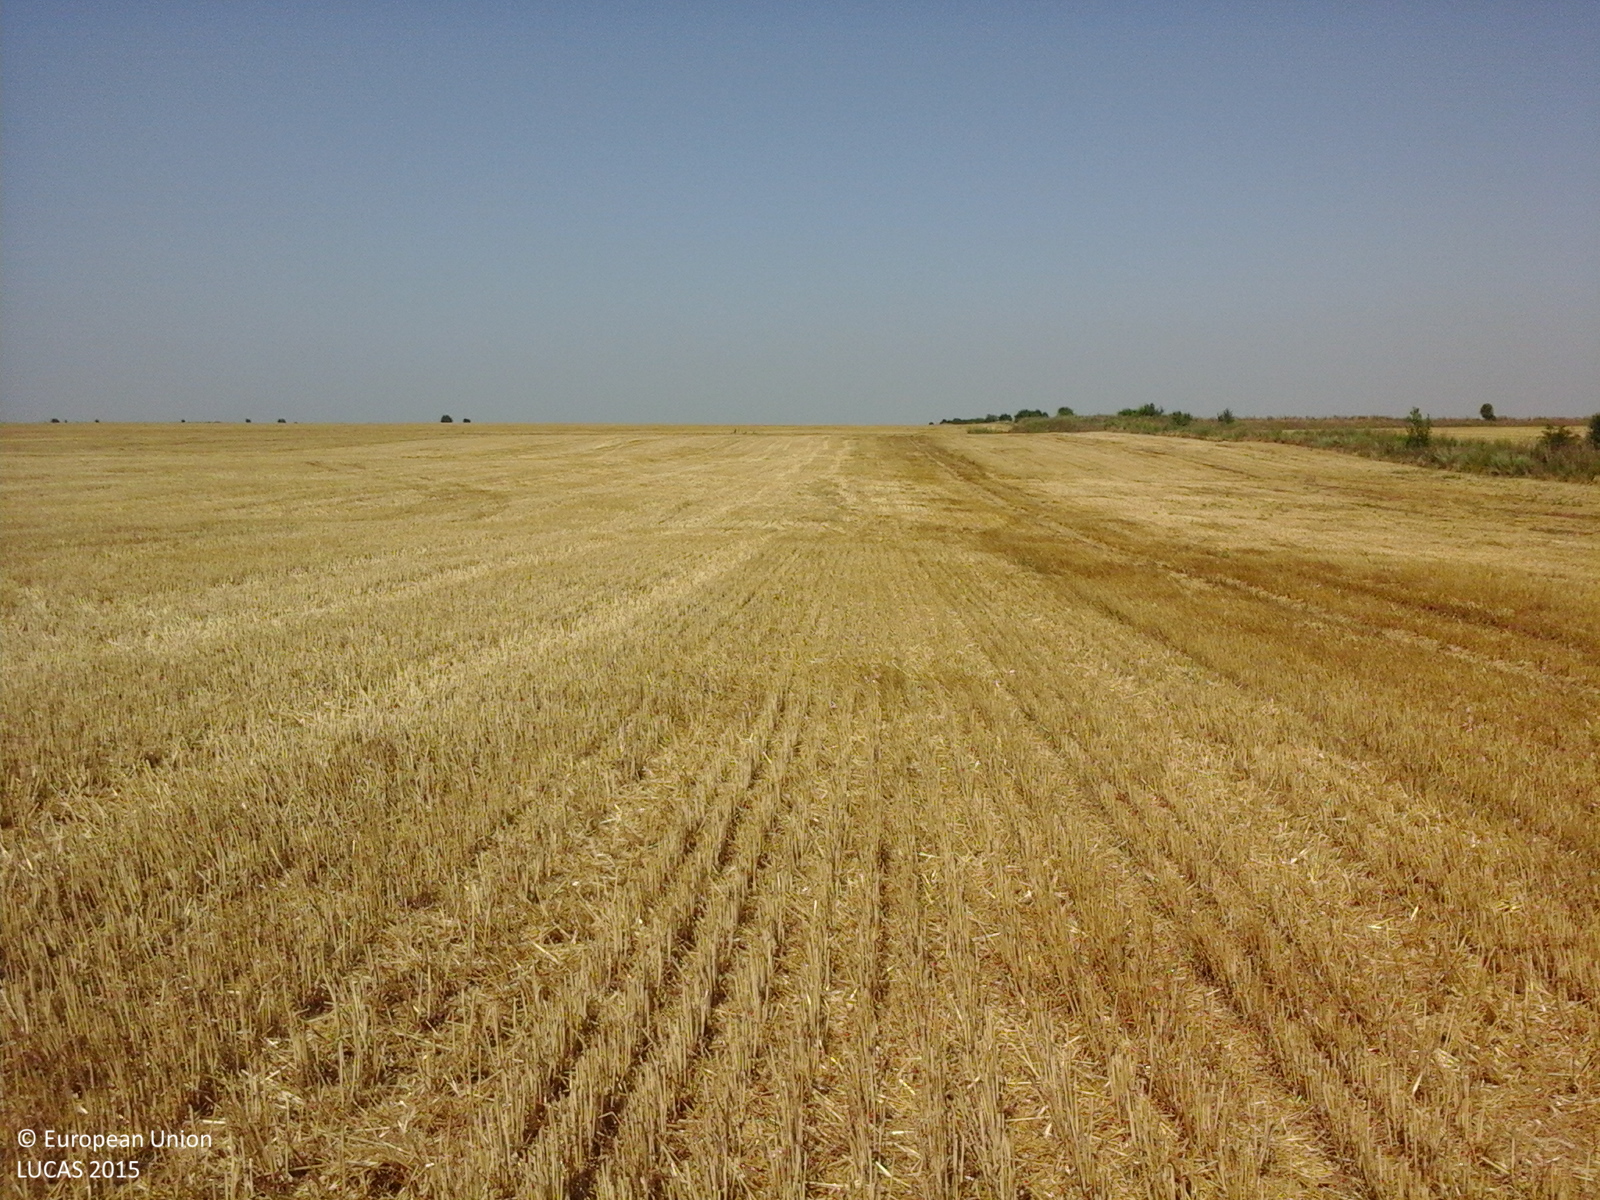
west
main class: Cropland
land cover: Durum wheat
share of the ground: > 75 %
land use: Agriculture (excluding fallow land and kitchen gardens)
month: July
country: RO
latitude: 44.2868
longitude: 27.4964
